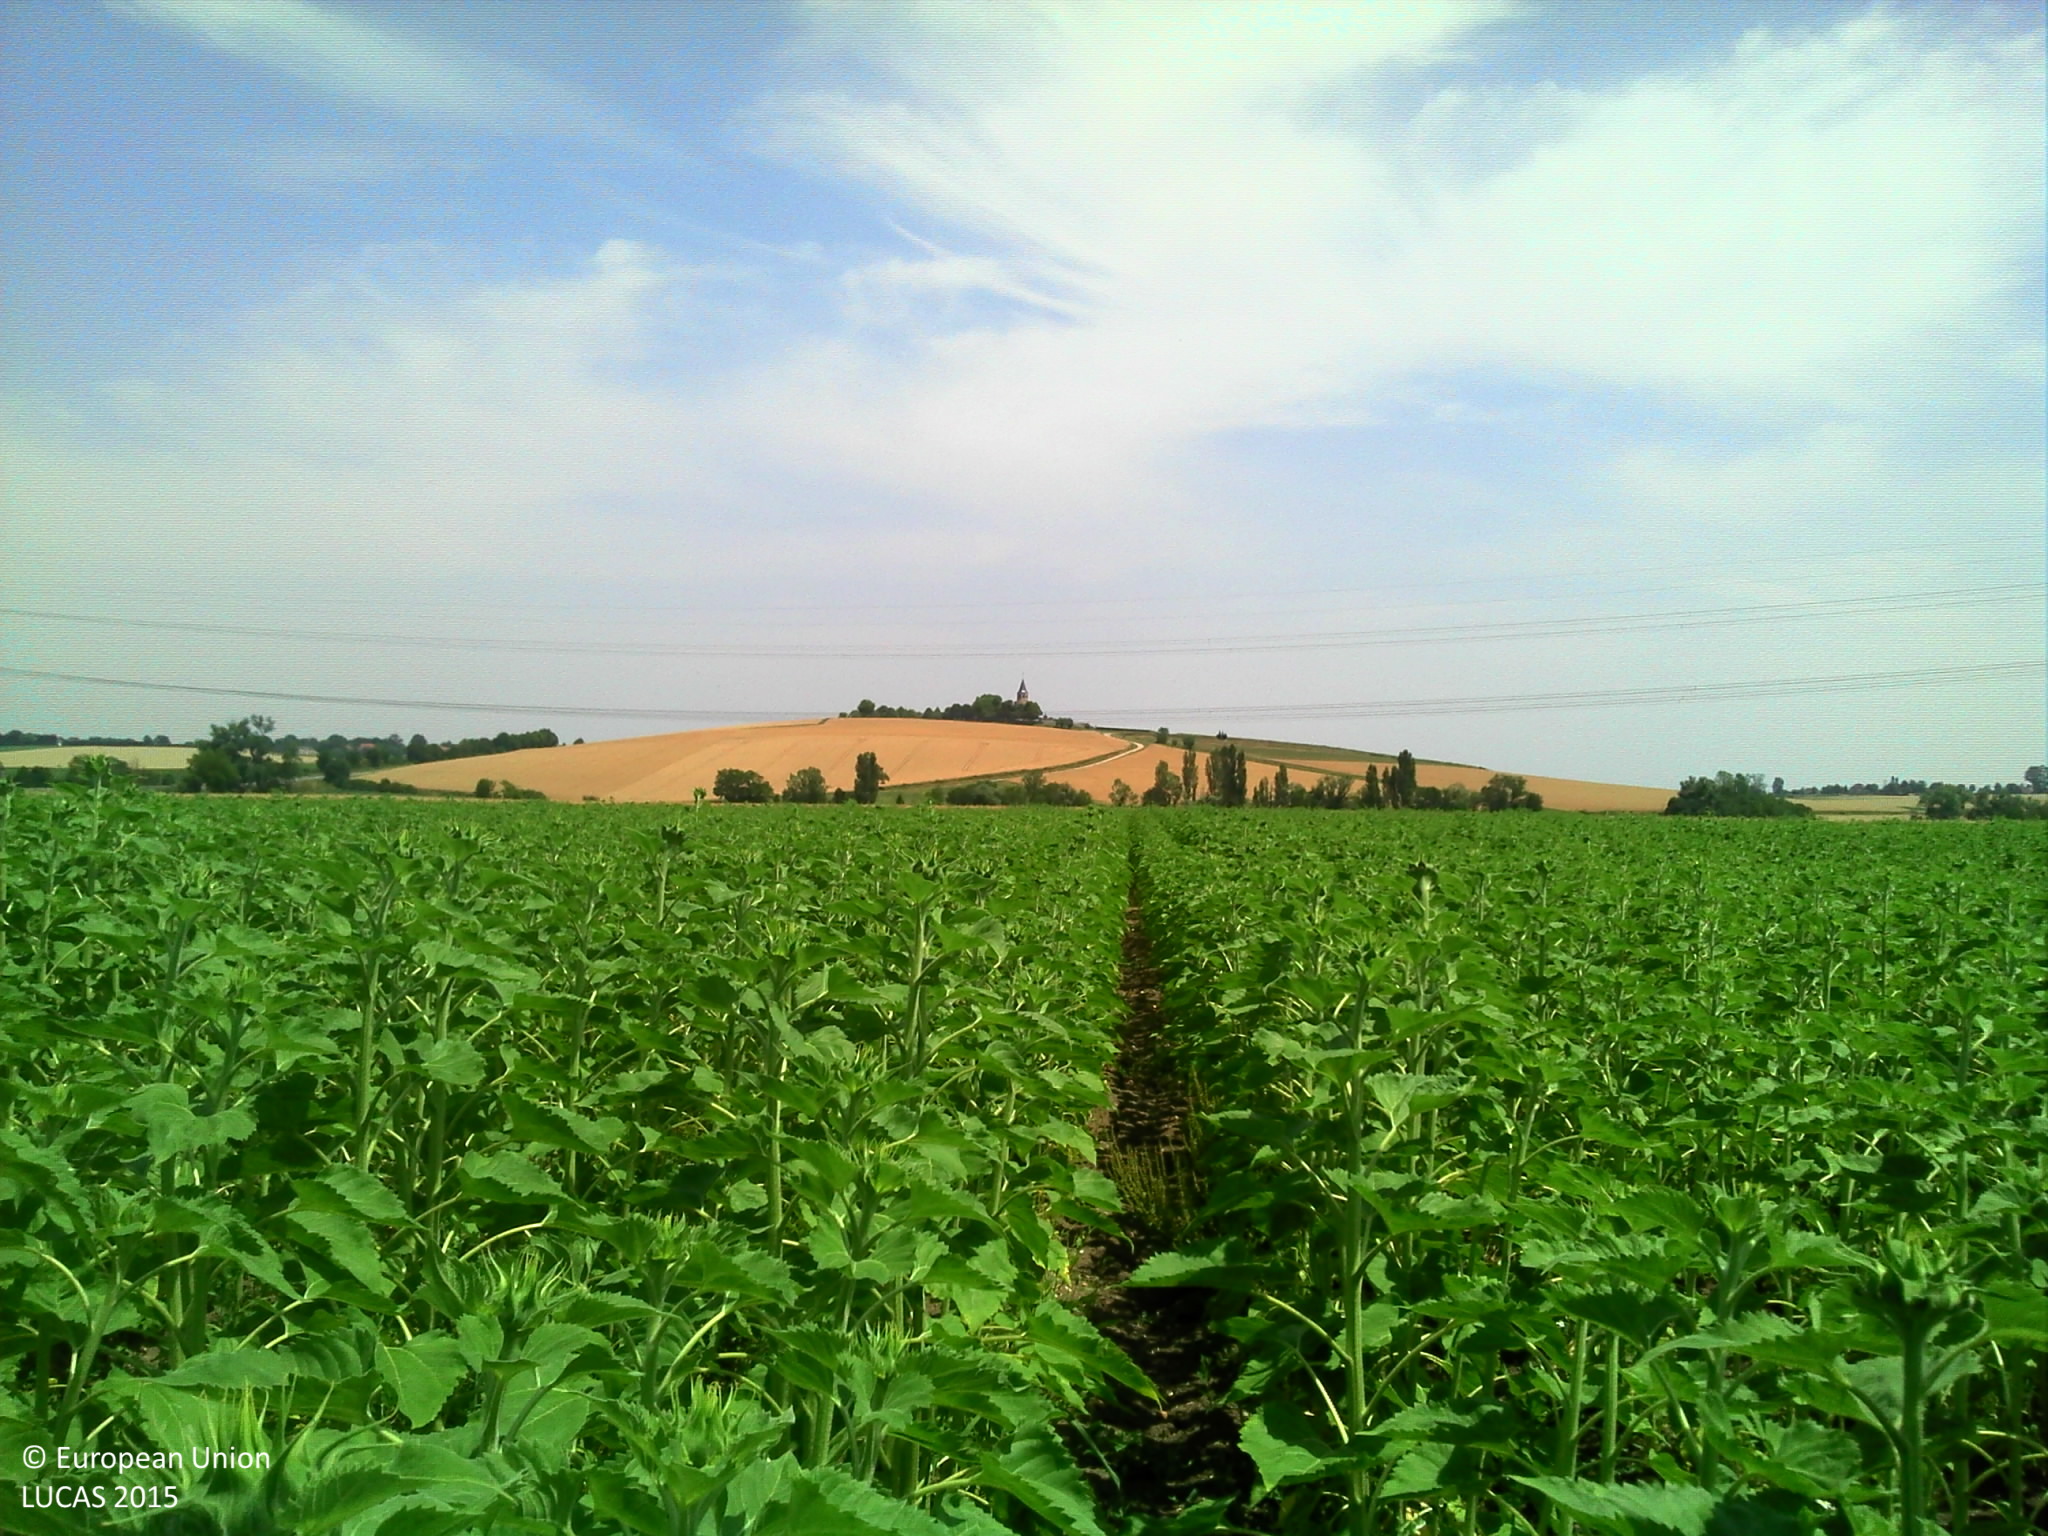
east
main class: Cropland
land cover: Sunflower
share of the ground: > 75 %
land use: Agriculture (excluding fallow land and kitchen gardens)
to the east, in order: Sunflower; Common wheat
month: July
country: FR
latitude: 46.1040
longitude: 3.2852
